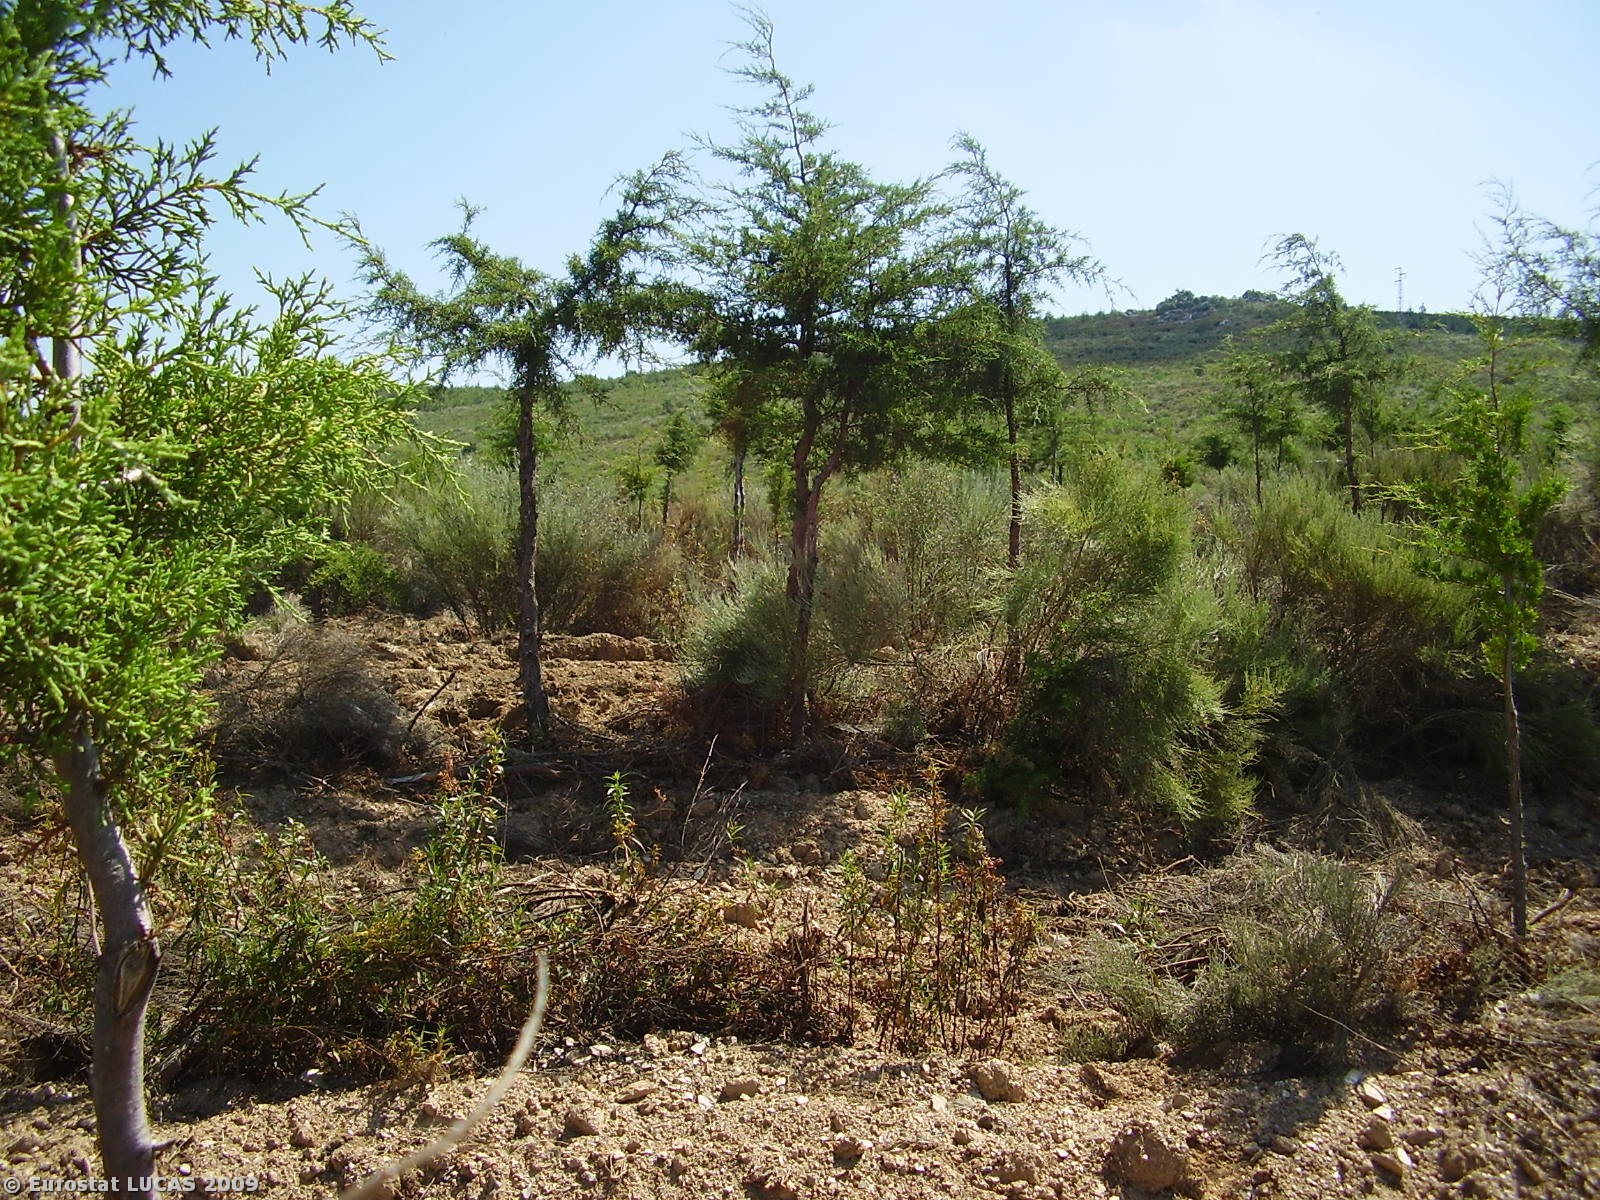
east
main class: Woodland
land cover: Coniferous woodland
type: coniferous forest of the mediterranean region
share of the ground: 10 - 25 %
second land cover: Spontaneously vegetated surfaces
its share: 10 - 25 %
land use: Forestry
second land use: Unused
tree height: > 5 m
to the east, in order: Coniferous woodland; Spontaneously vegetated surfaces; Coniferous woodland; Tracks; Spontaneously vegetated surfaces
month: June
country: PT
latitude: 41.6153
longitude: -6.5342
